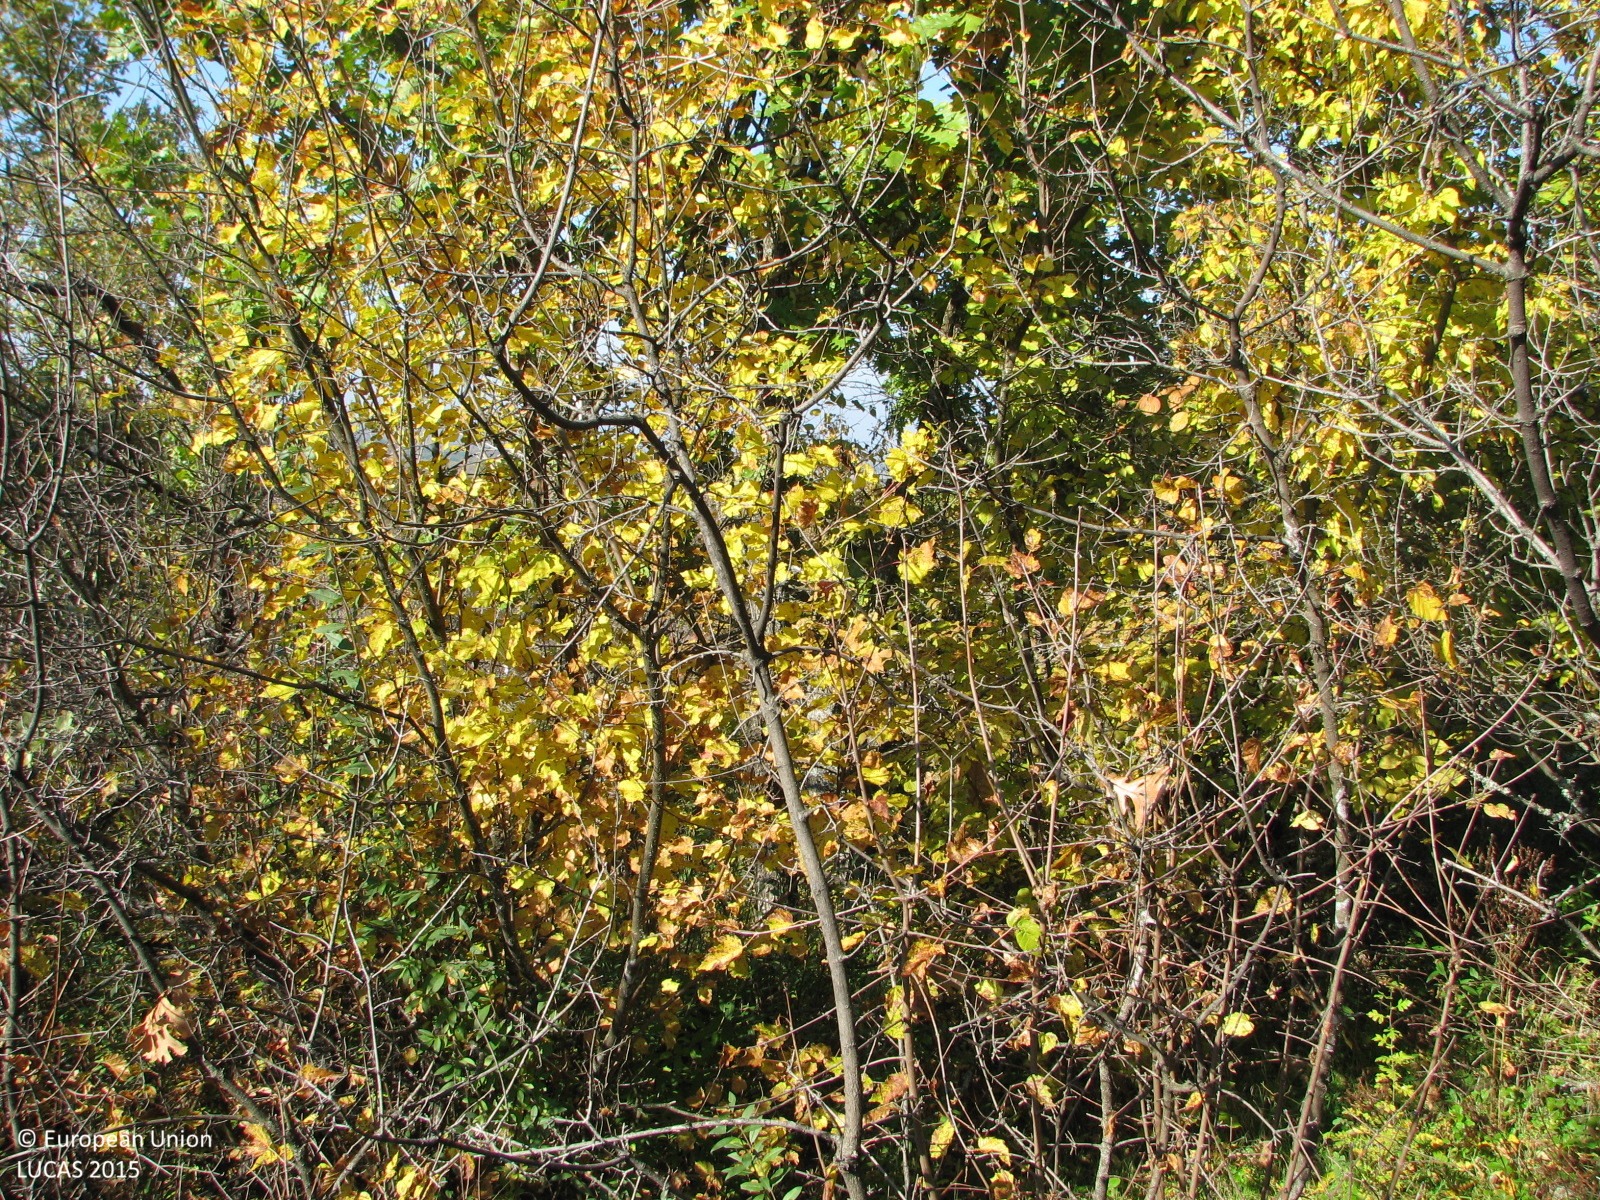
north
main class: Shrubland
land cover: Shrubland with sparse tree cover
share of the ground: 50 - 75 %
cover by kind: shrubs 50 %, herbaceous plants 45 %, broadleaved forest trees 5 %
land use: Semi-natural and natural areas not in use
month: November
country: BG
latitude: 42.0643
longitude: 26.7084
